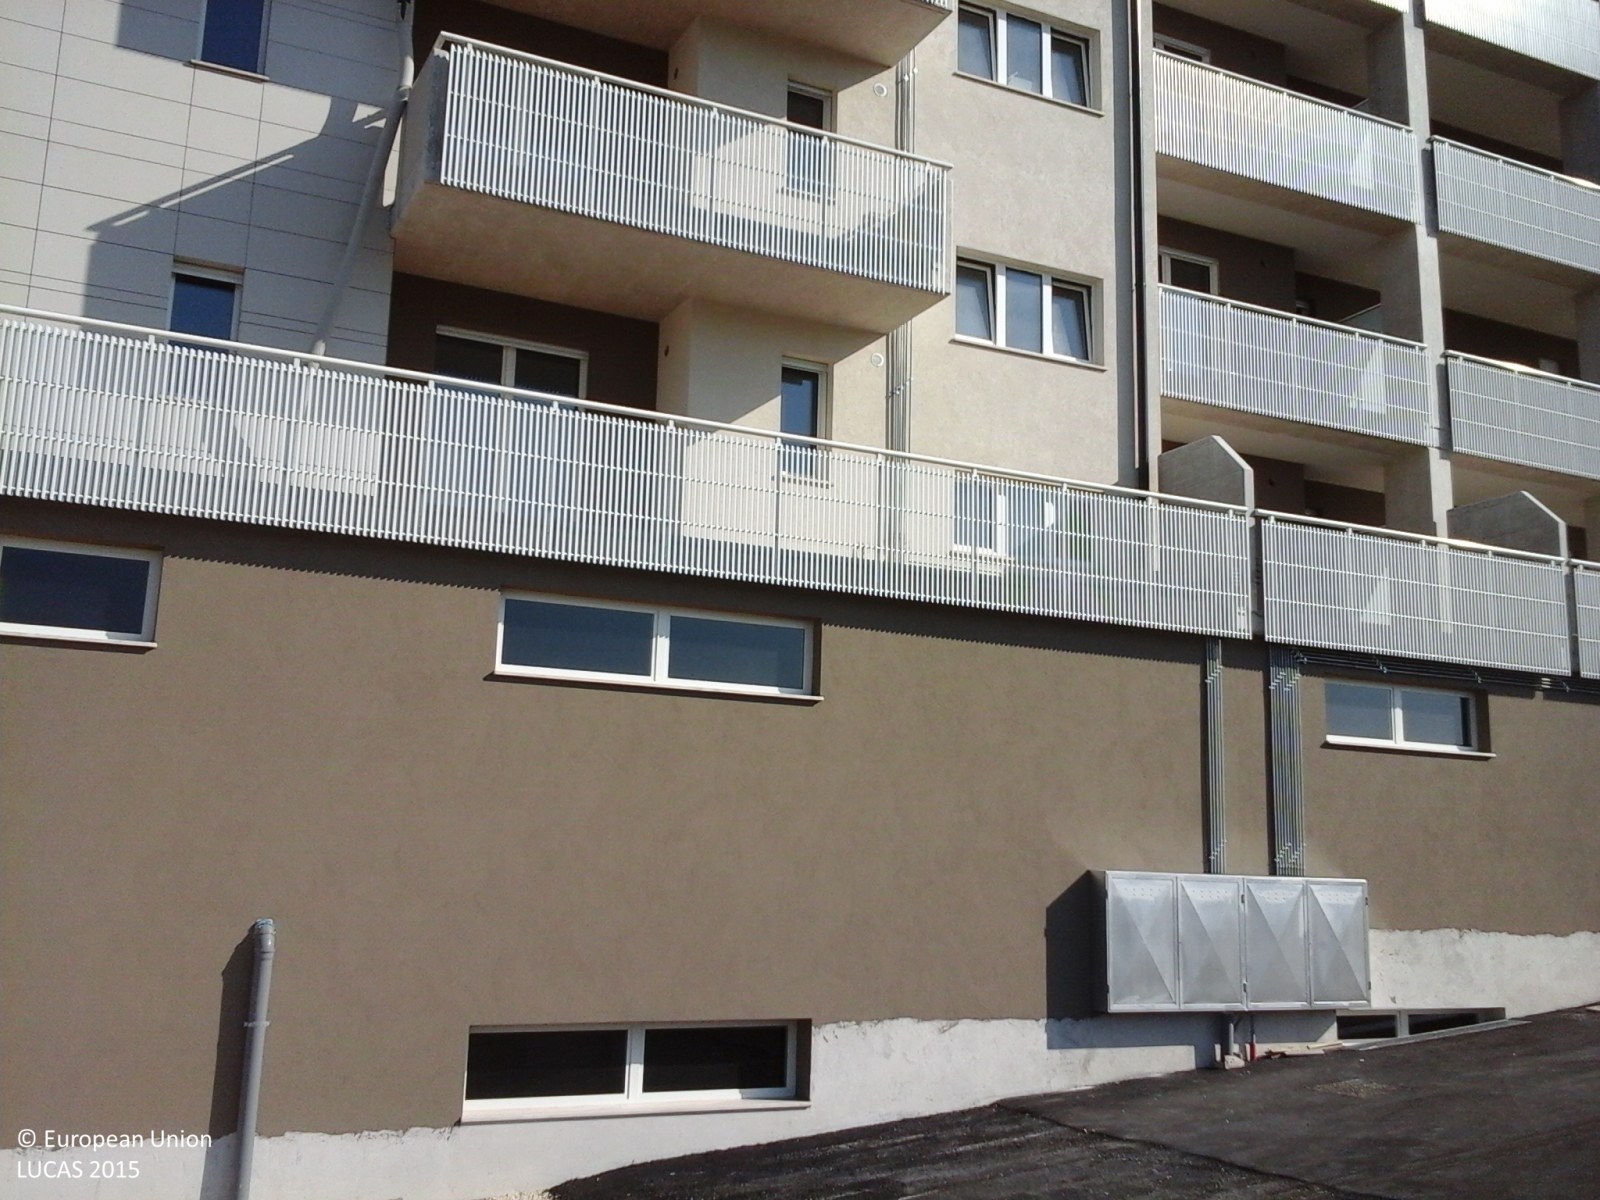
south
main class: Cropland
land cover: Vineyards
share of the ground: 50 - 75 %
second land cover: Spontaneously vegetated surfaces
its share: > 75 %
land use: Agriculture (excluding fallow land and kitchen gardens)
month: July
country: IT
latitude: 41.5510
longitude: 14.6714
